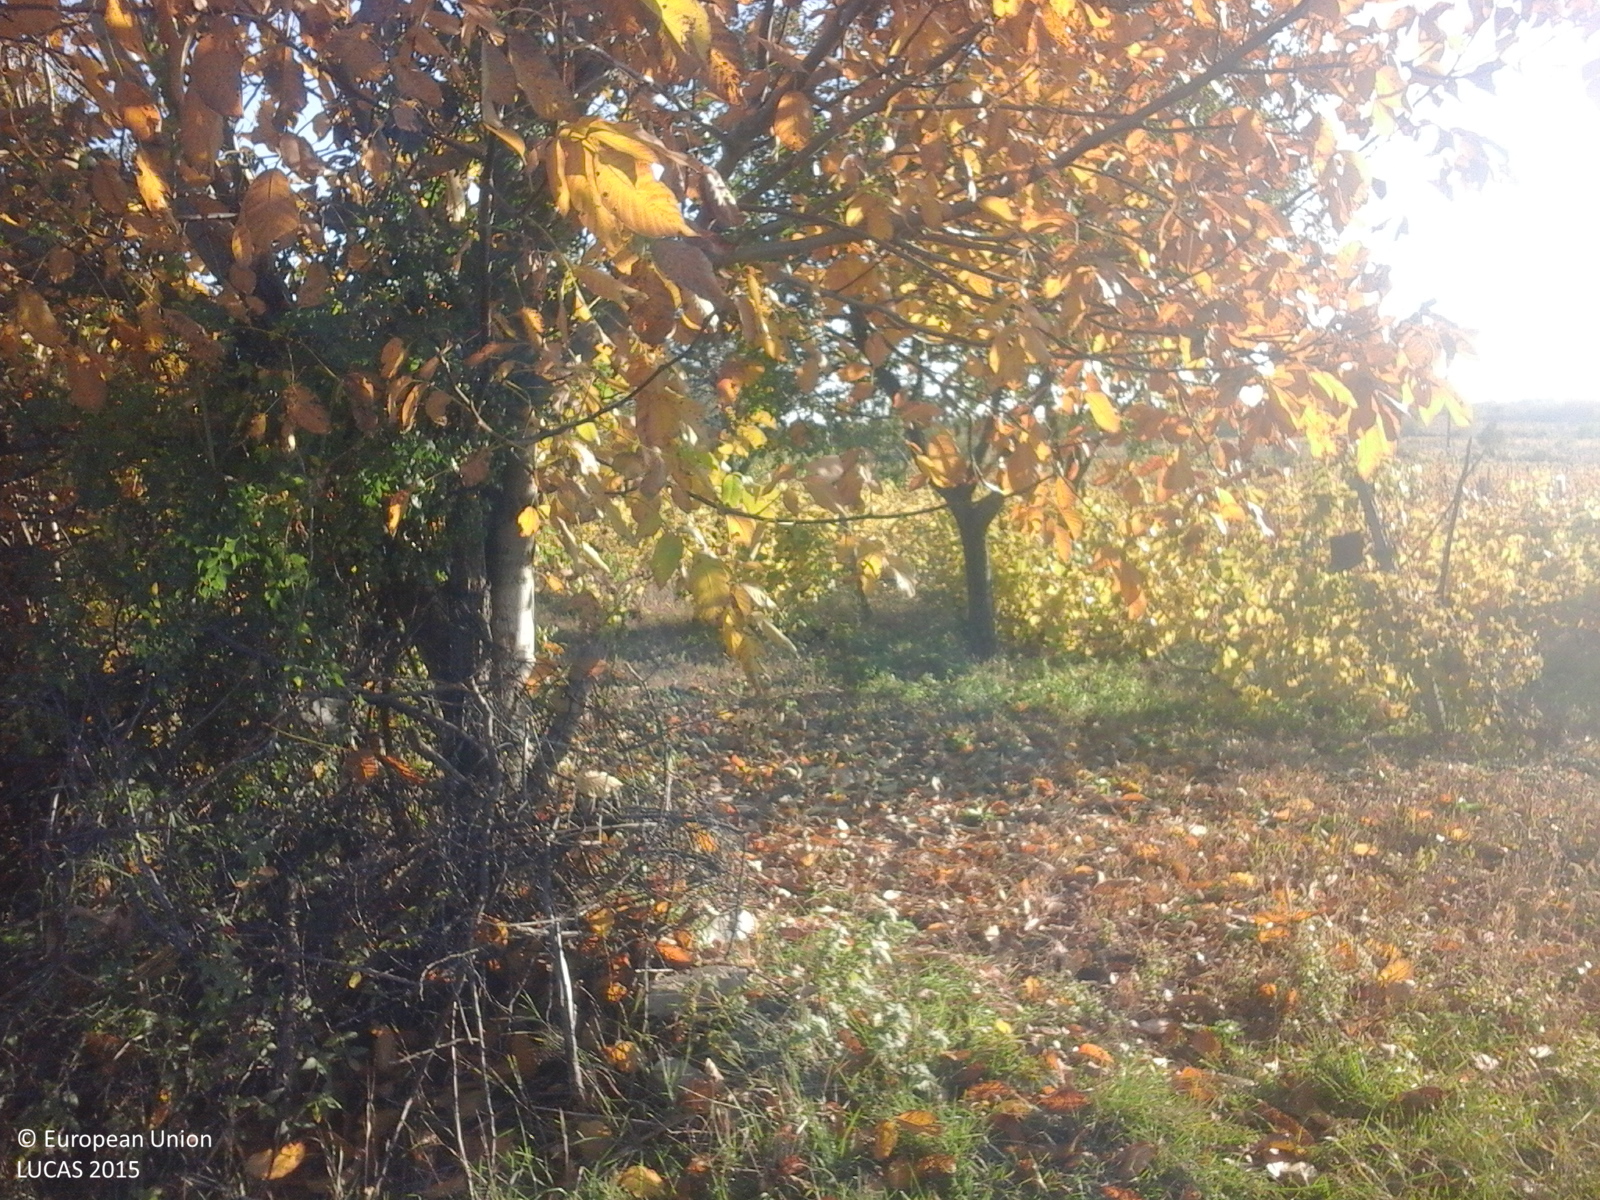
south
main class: Cropland
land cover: Maize
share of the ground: > 75 %
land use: Agriculture (excluding fallow land and kitchen gardens)
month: October
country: RO
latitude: 45.8517
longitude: 27.0528
